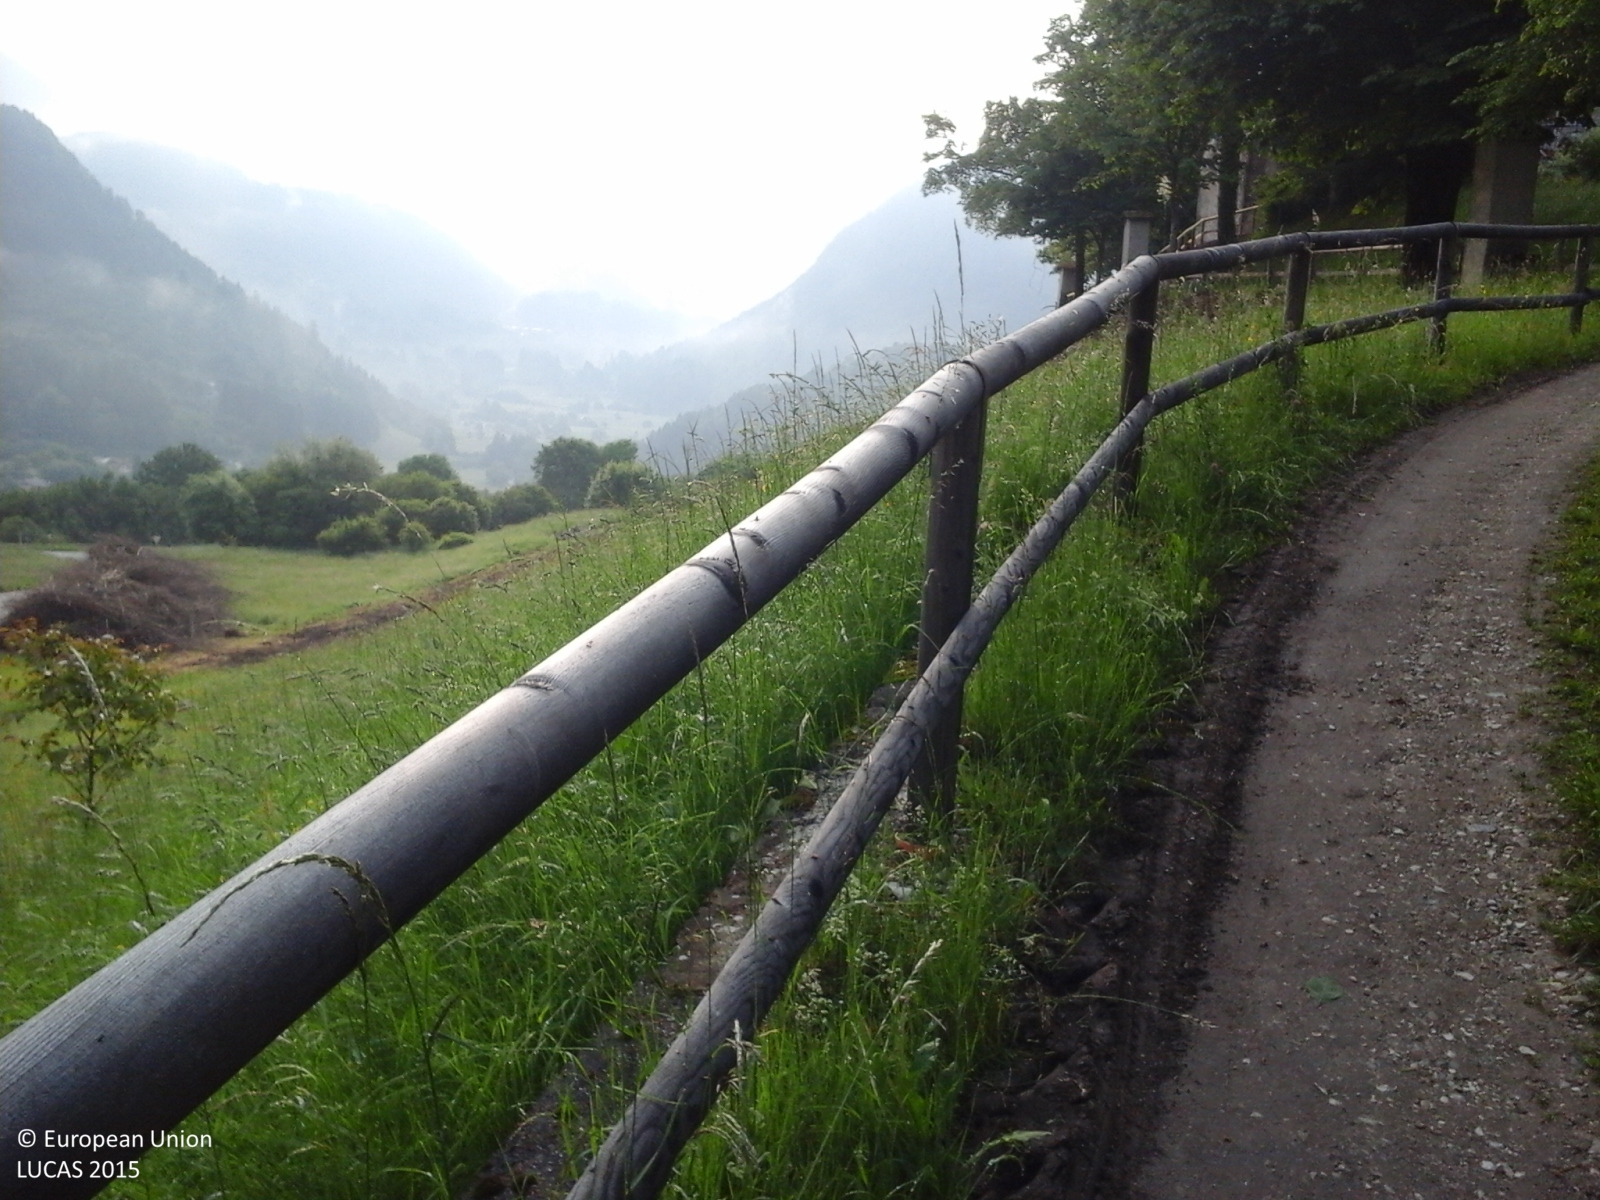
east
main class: Grassland
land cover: Grassland without tree/shrub cover
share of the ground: > 75 %
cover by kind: herbaceous plants 90 %, consolidated bare surface 5 %, unconsolidated bare surface 5 %
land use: Agriculture (excluding fallow land and kitchen gardens)
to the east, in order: Tracks; Fences; Grassland without tree/shrub cover; Grassland with sparse tree/shrub cover; Grassland without tree/shrub cover; Other bare soil; Tracks; Grassland without tree/shrub cover; Grassland with sparse tree/shrub cover; Tracks; Other bare soil; Grassland with sparse tree/shrub cover; Paved roads, cycling and walking lanes; Grassland without tree/shrub cover
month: May
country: IT
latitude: 46.0688
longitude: 11.6138
